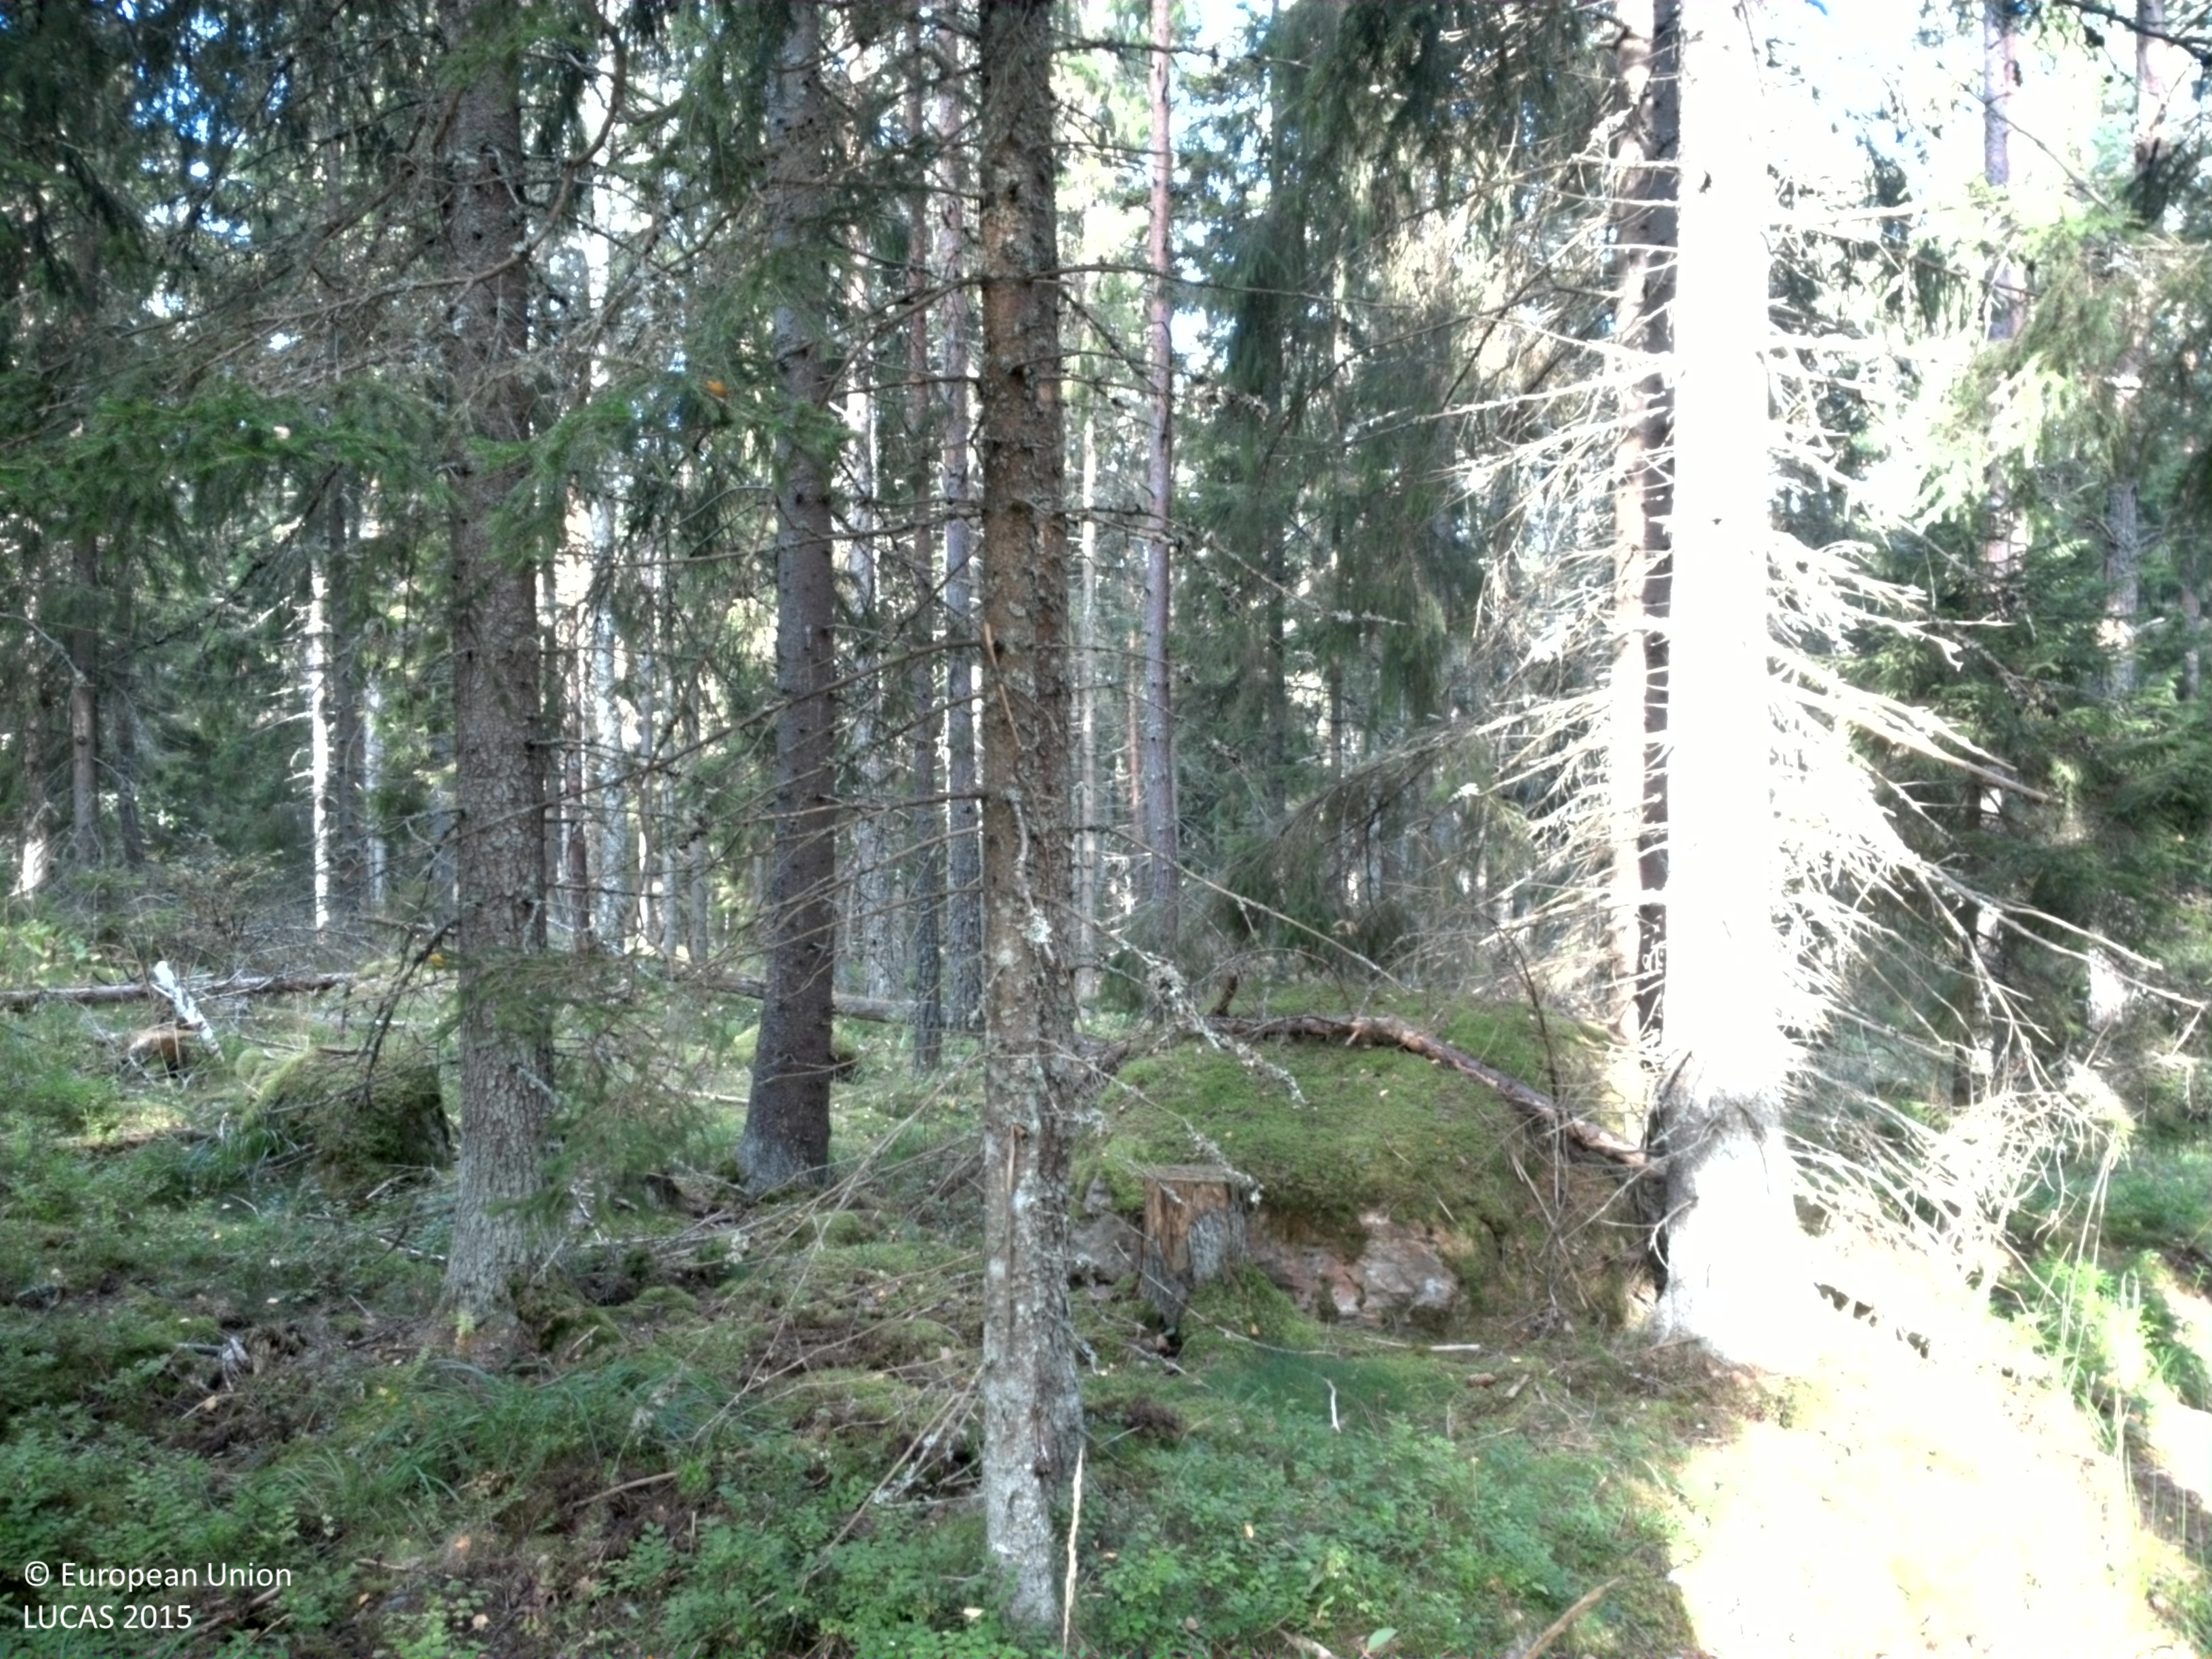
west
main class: Woodland
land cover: Spruce dominated coniferous woodland
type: boreal forest
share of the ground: > 75 %
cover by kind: coniferous forest trees 70 %, lichens and mosses 25 %, broadleaved forest trees 5 %
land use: Forestry
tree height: > 5 m
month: August
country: SE
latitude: 59.8145
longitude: 17.8945
